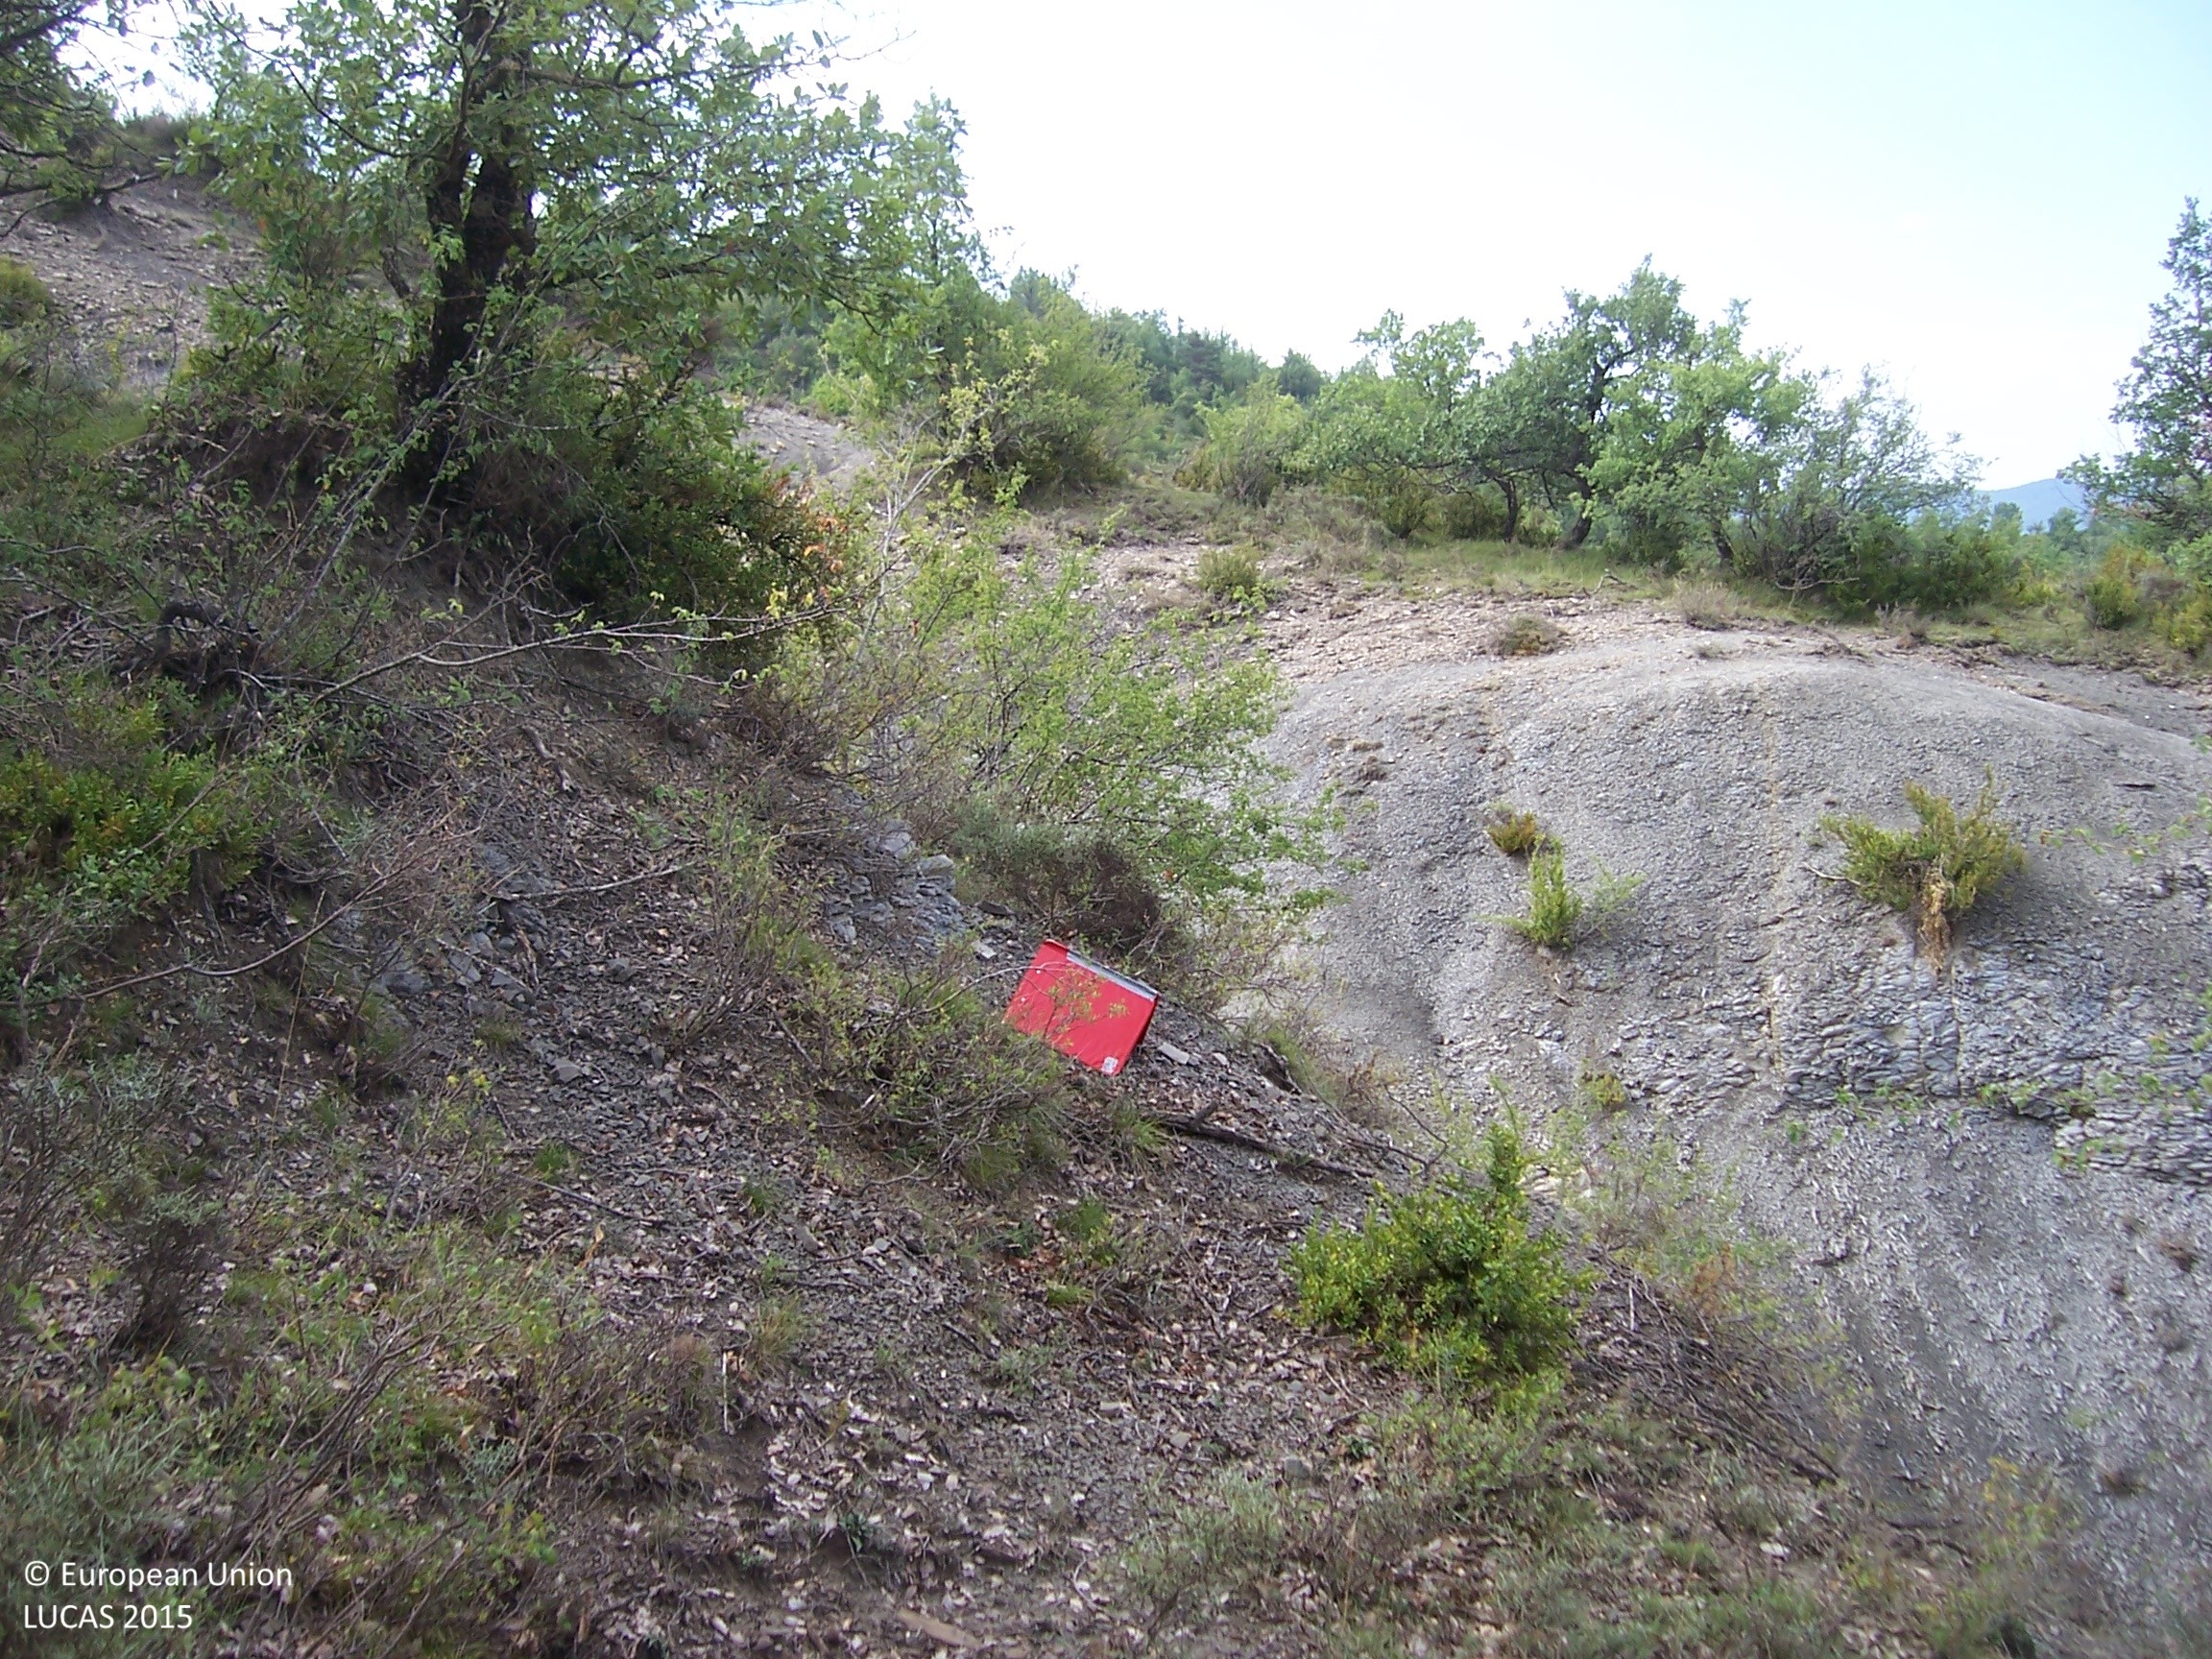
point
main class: Woodland
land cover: Broadleaved woodland
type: acidophilous oak and oak-birch forest
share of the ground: > 75 %
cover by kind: consolidated bare surface 60 %, broadleaved forest trees 30 %, shrubs 10 %
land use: Semi-natural and natural areas not in use
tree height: > 5 m
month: August
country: ES
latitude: 42.5573
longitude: -0.3662
